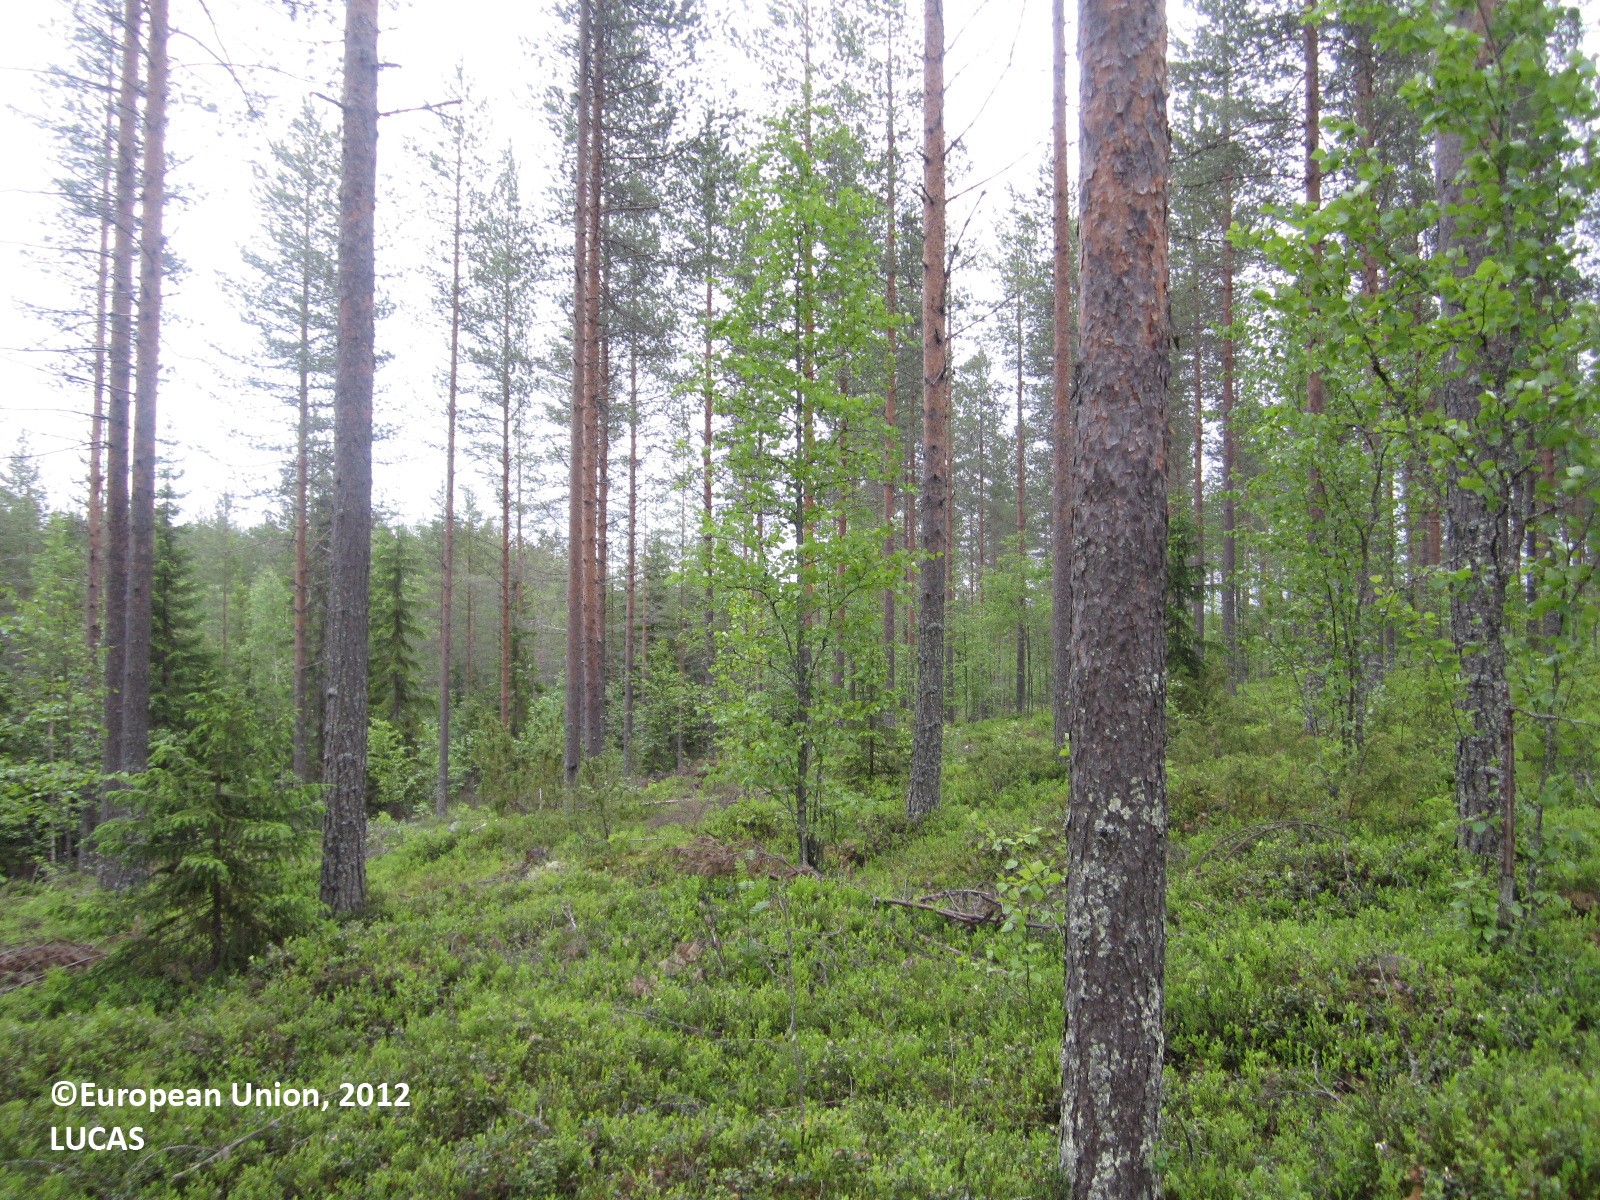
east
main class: Woodland
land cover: Pine dominated coniferous woodland
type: boreal forest
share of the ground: 50 - 75 %
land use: Forestry
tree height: > 5 m
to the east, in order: Pine dominated coniferous woodland; Tracks; Pine dominated coniferous woodland; Tracks; Pine dominated coniferous woodland; Tracks; Pine dominated mixed woodland; Rivers and streams; Pine dominated mixed woodland; Tracks; Pine dominated coniferous woodland; Ditches and canals; Spontaneously vegetated surfaces; Paved roads, cycling and walking lanes; Spontaneously vegetated surfaces
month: June
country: FI
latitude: 64.4580
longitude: 29.5258
